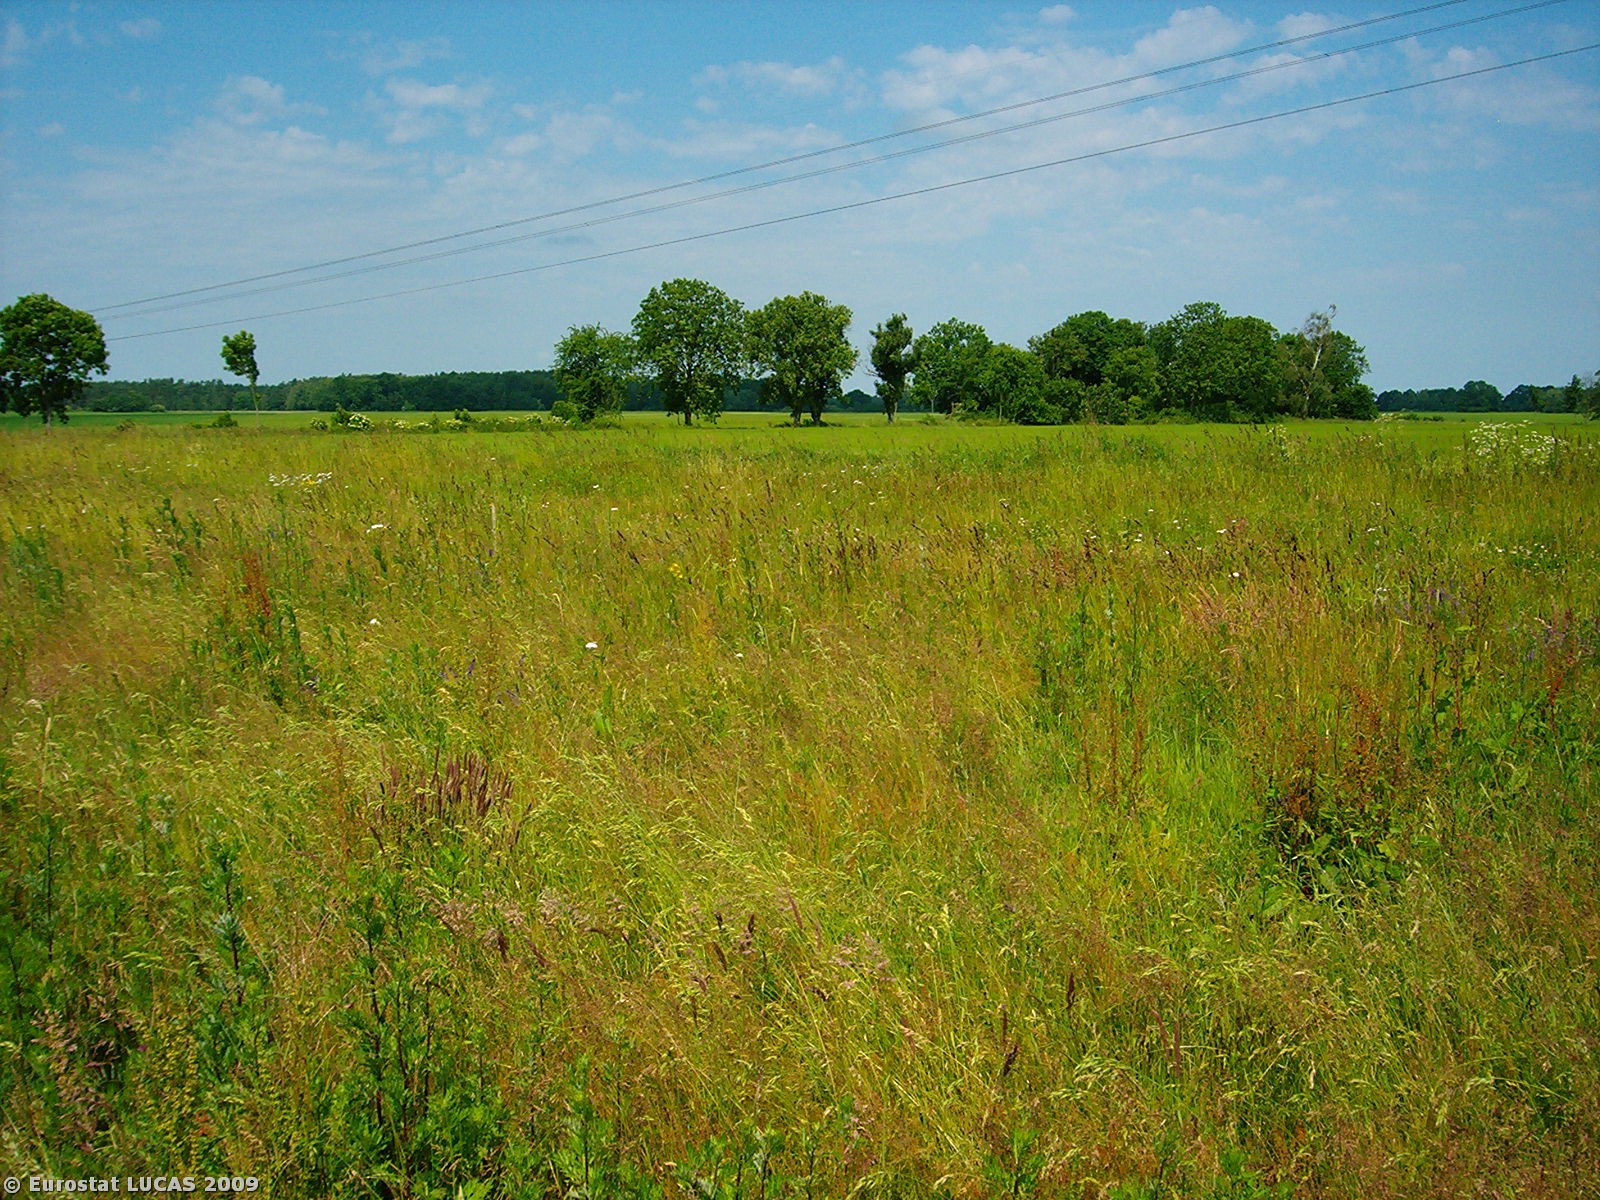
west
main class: Grassland
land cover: Grassland without tree/shrub cover
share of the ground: < 10 %
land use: Agriculture (excluding fallow land and kitchen gardens)
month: June
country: PL
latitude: 53.7079
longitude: 15.5329
